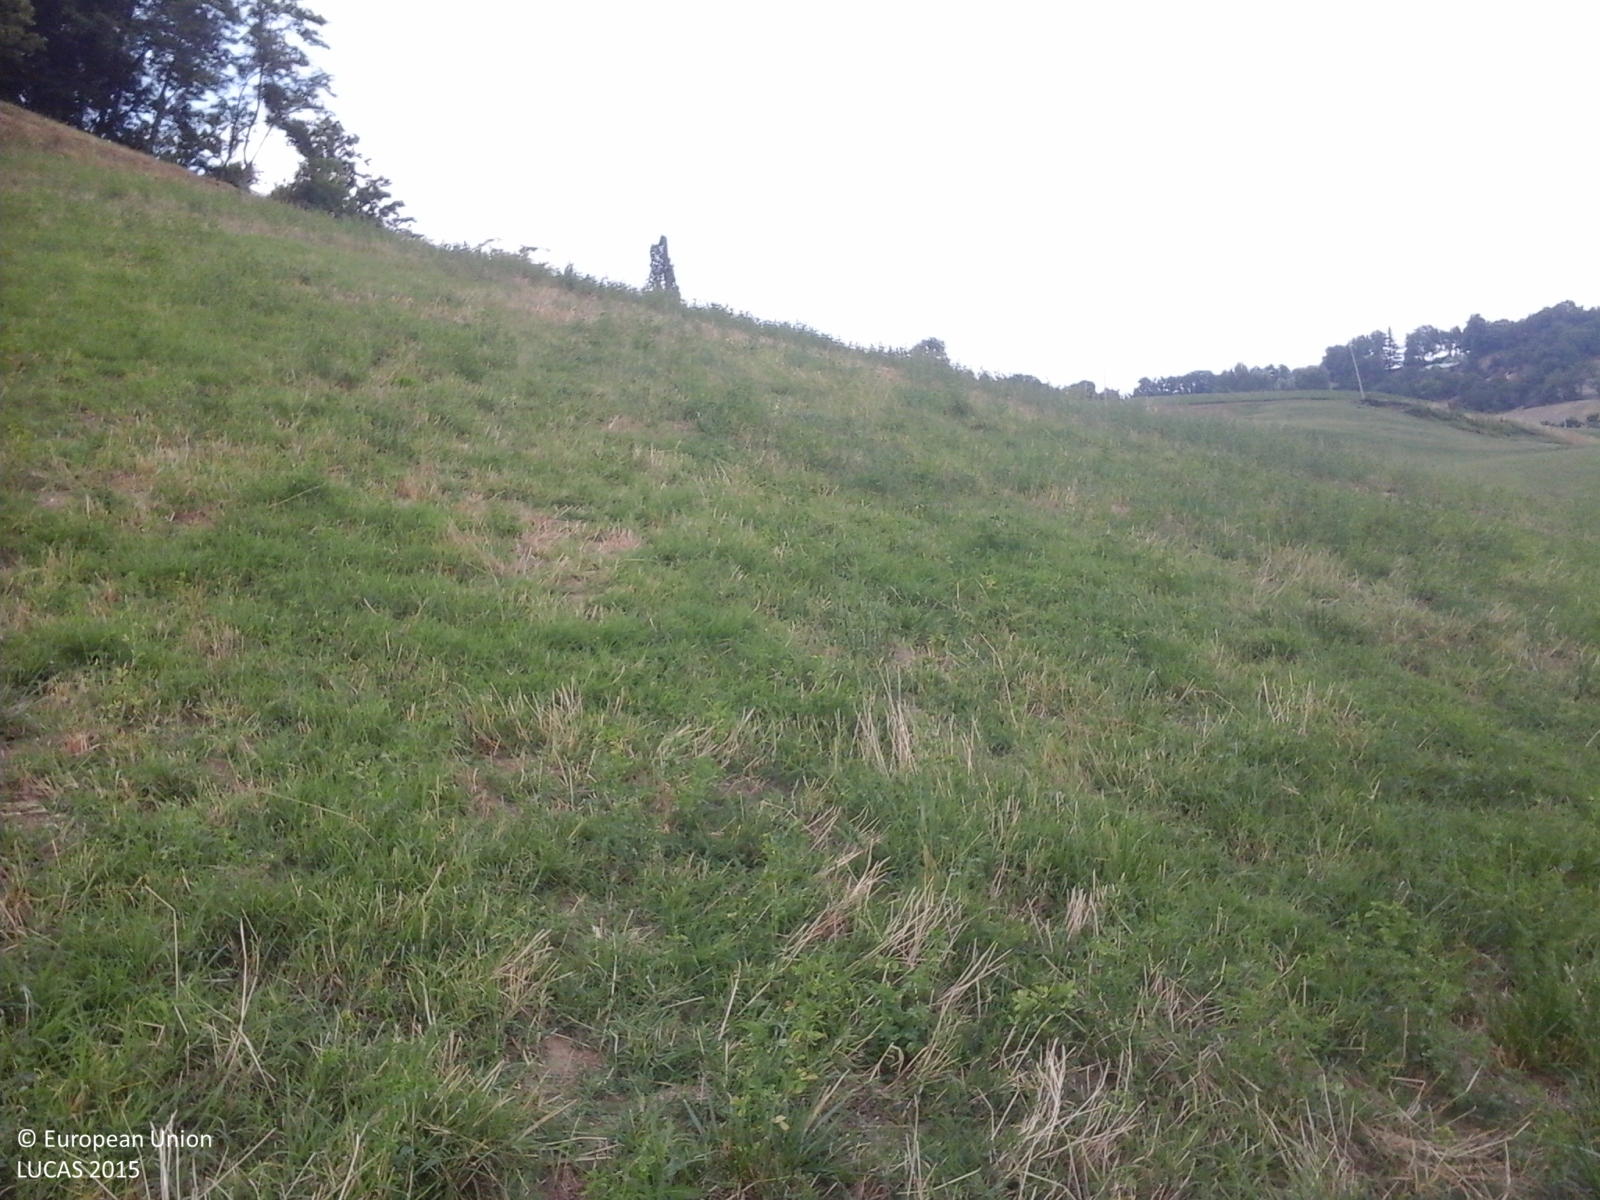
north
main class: Grassland
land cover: Grassland without tree/shrub cover
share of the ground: > 75 %
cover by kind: herbaceous plants 100 %
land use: Agriculture (excluding fallow land and kitchen gardens)
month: June
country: IT
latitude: 44.5666
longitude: 10.2890
